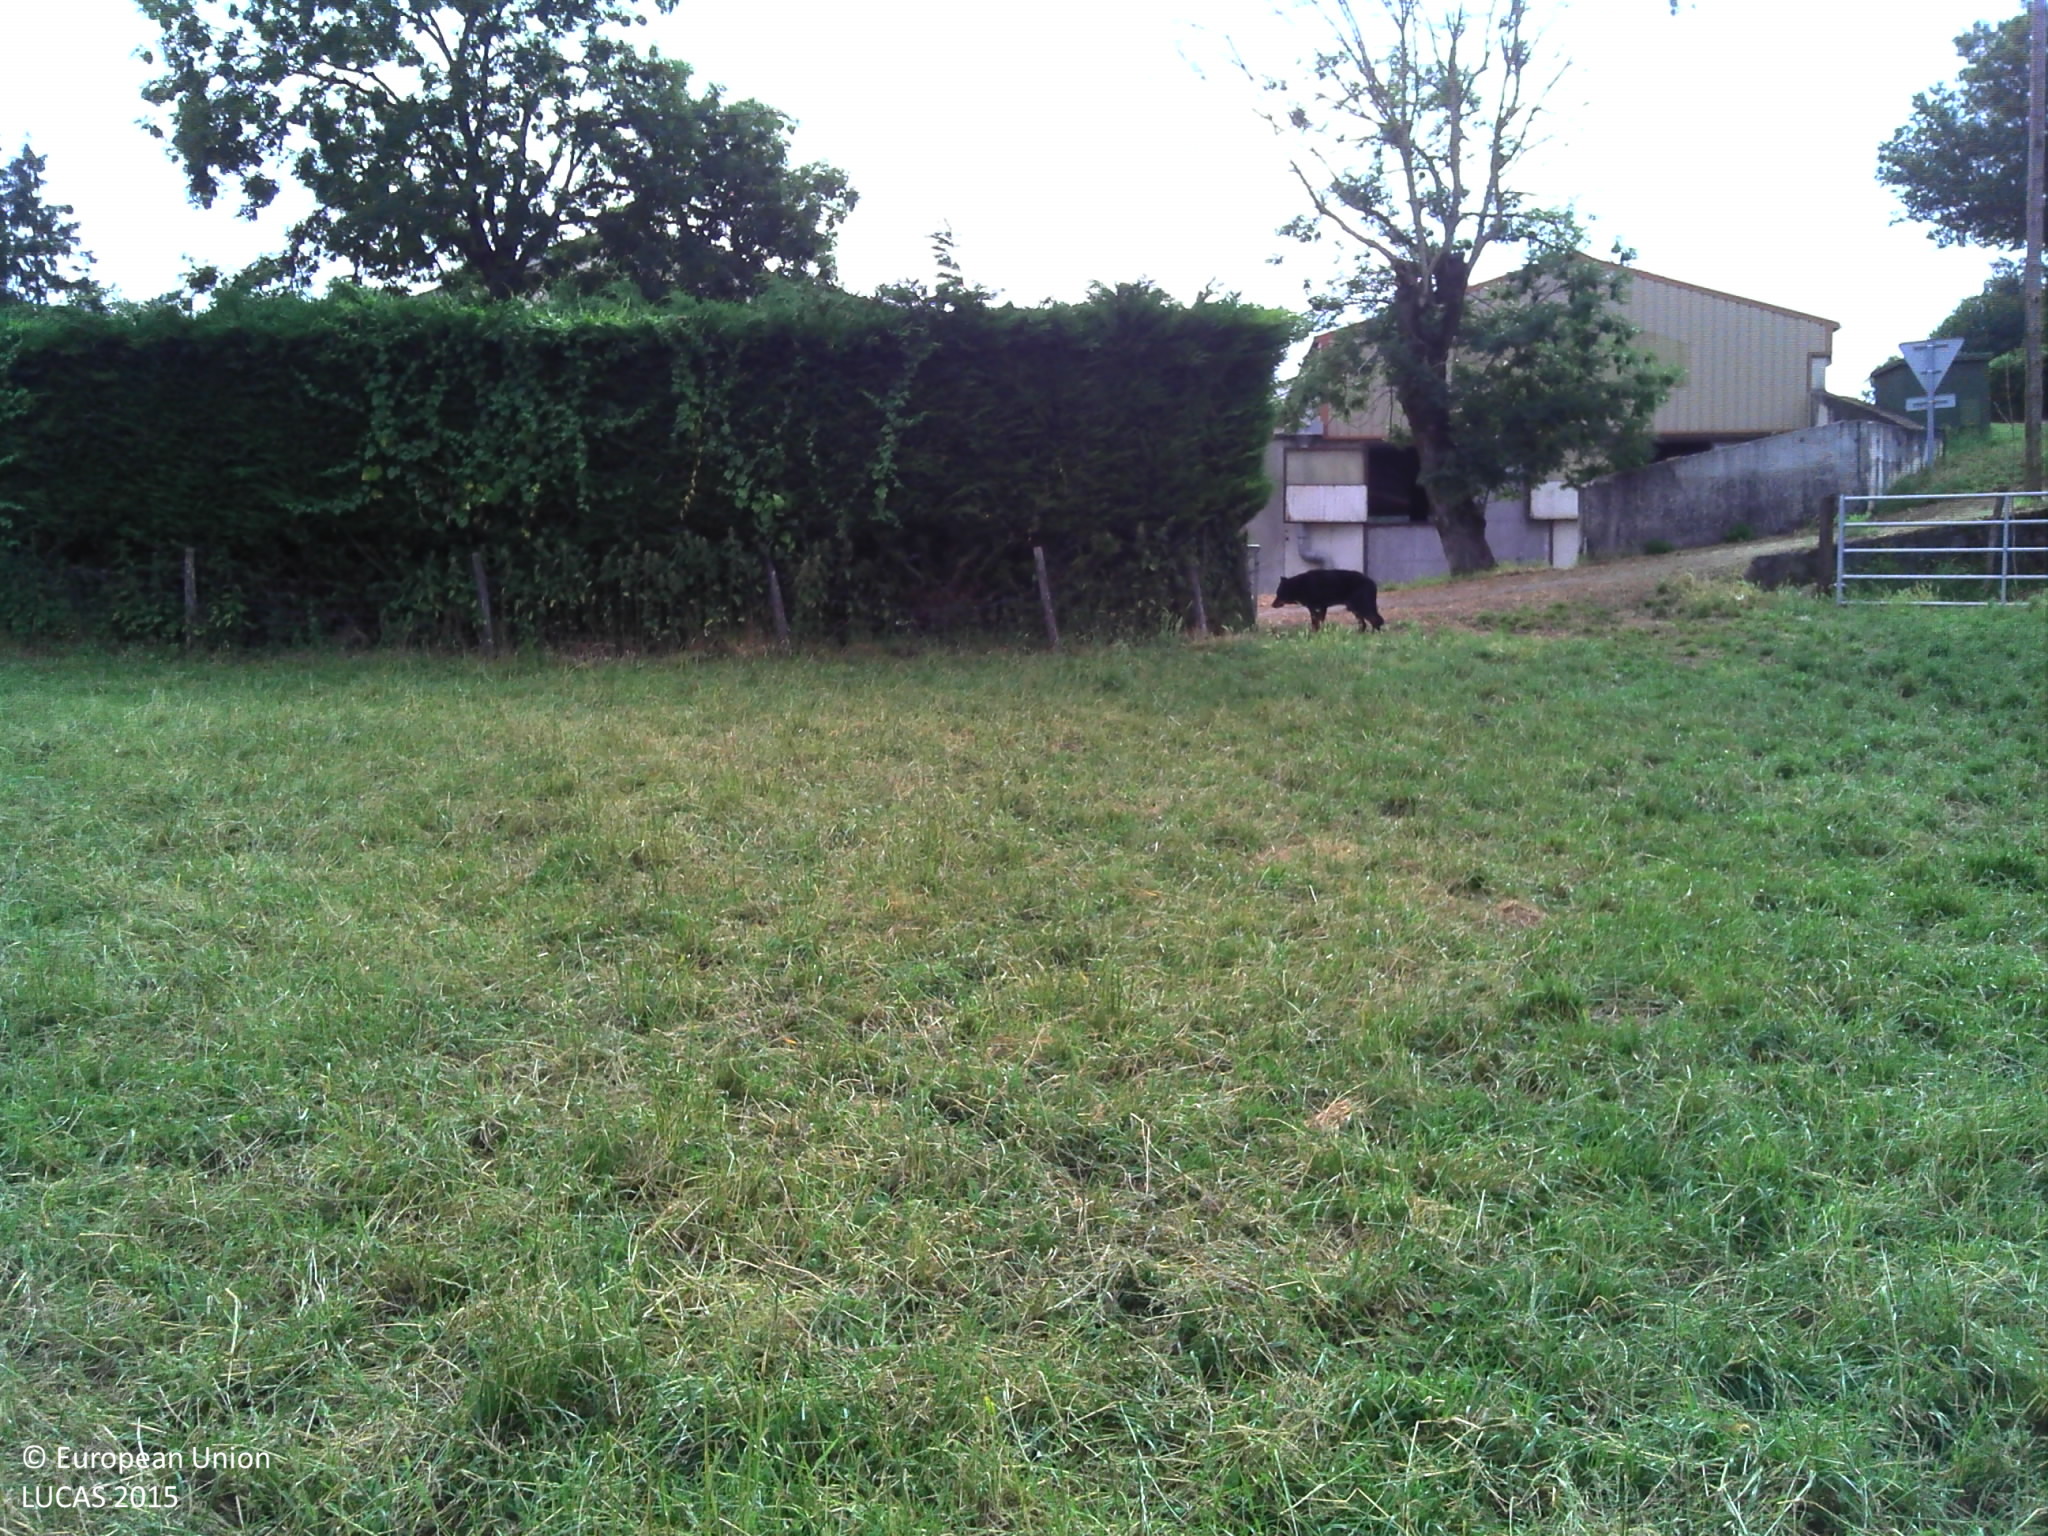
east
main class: Cropland
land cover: Temporary grasslands
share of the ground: > 75 %
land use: Agriculture (excluding fallow land and kitchen gardens)
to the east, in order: Temporary grasslands; Artificial constructions in urban areas; Spontaneously vegetated surfaces; Fences; Grassland without tree/shrub cover
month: June
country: FR
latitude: 44.2296
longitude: 2.5800
